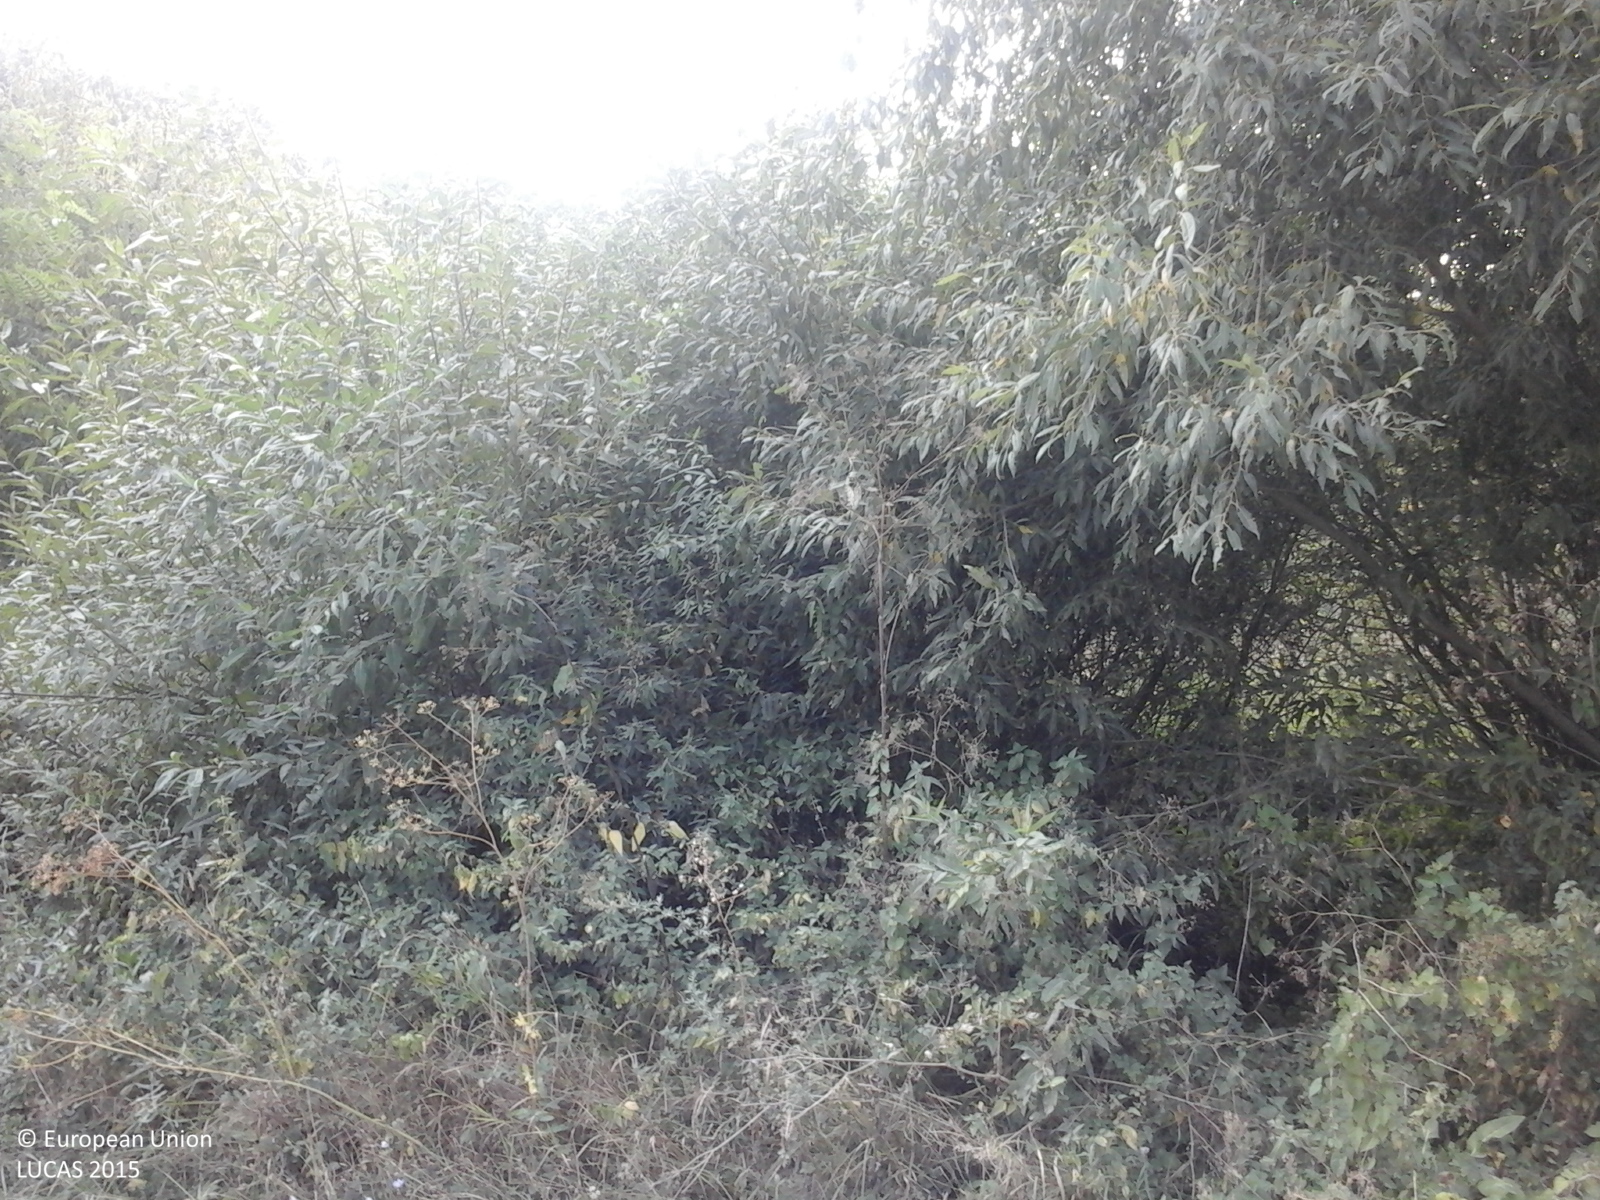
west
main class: Woodland
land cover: Broadleaved woodland
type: floodplain forest
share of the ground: > 75 %
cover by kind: broadleaved forest trees 100 %
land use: Semi-natural and natural areas not in use
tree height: > 5 m
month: September
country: RO
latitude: 47.2244
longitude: 24.0685
